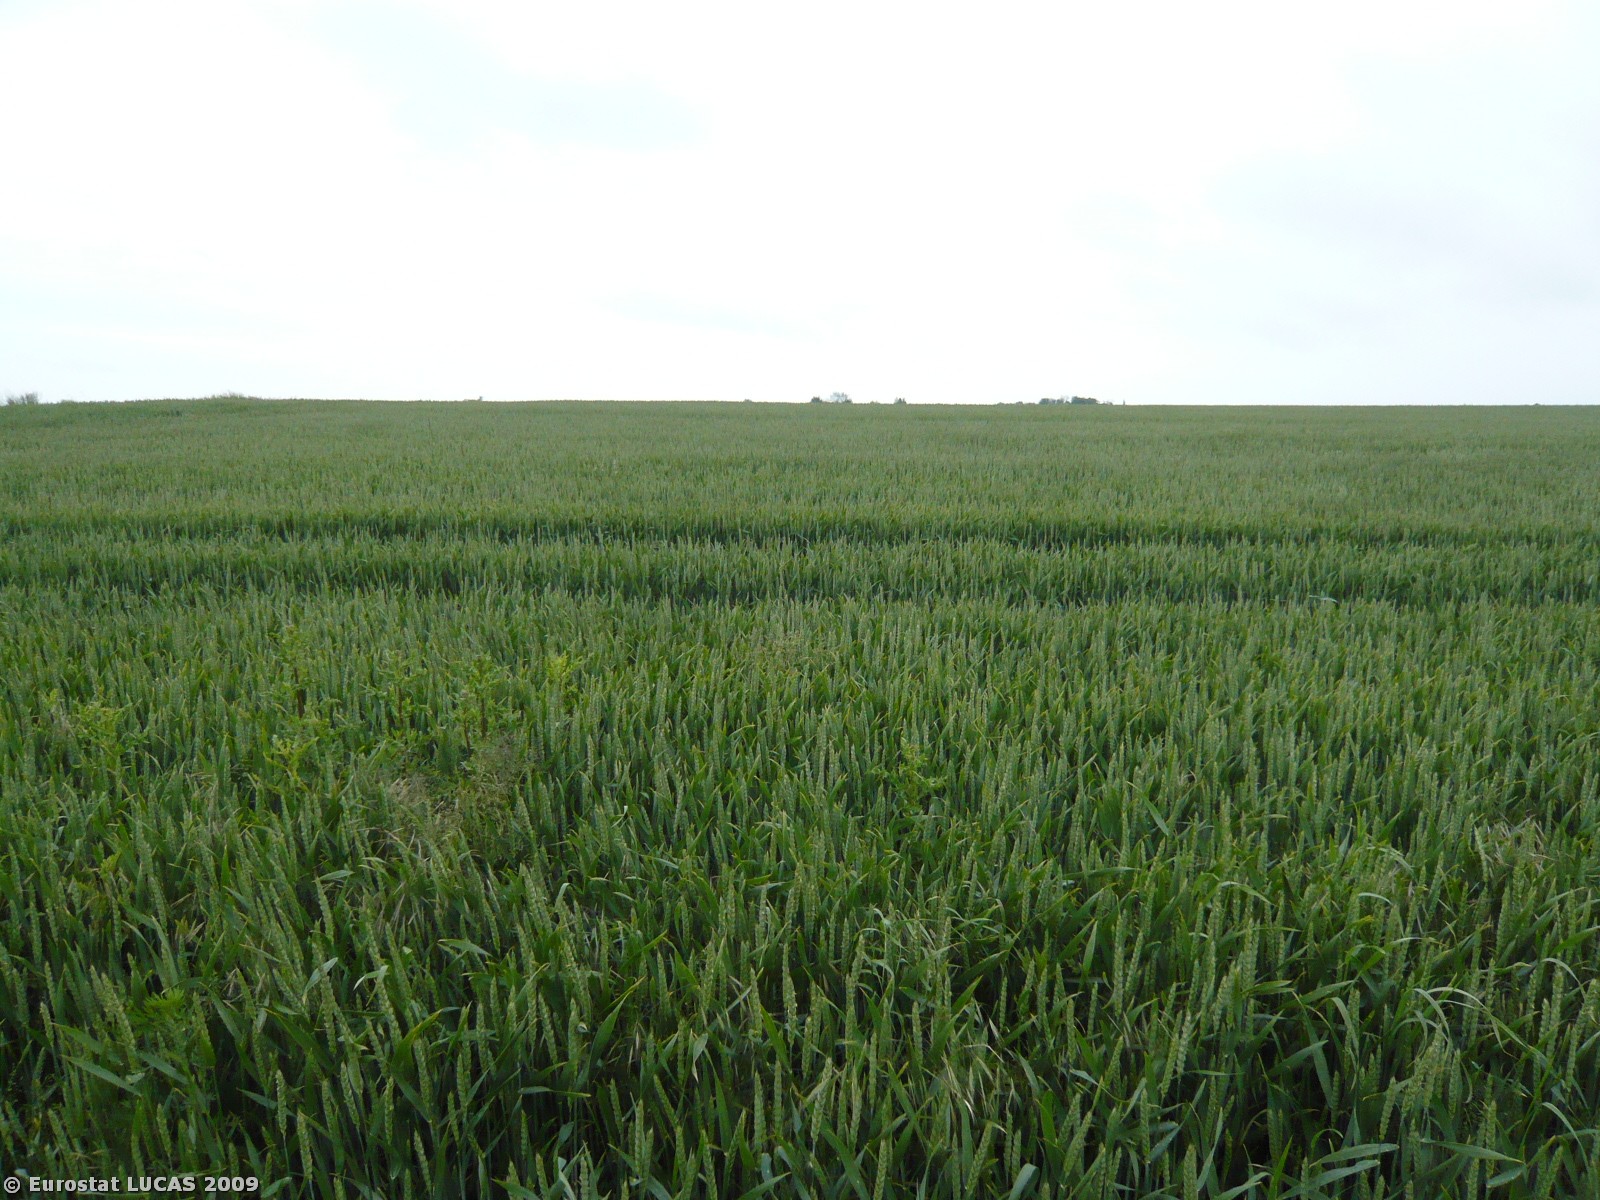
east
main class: Grassland
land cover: Grassland with sparse tree/shrub cover
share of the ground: > 75 %
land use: Residential
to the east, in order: Grassland with sparse tree/shrub cover; Common wheat
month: June
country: DK
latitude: 54.7522
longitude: 11.9720
